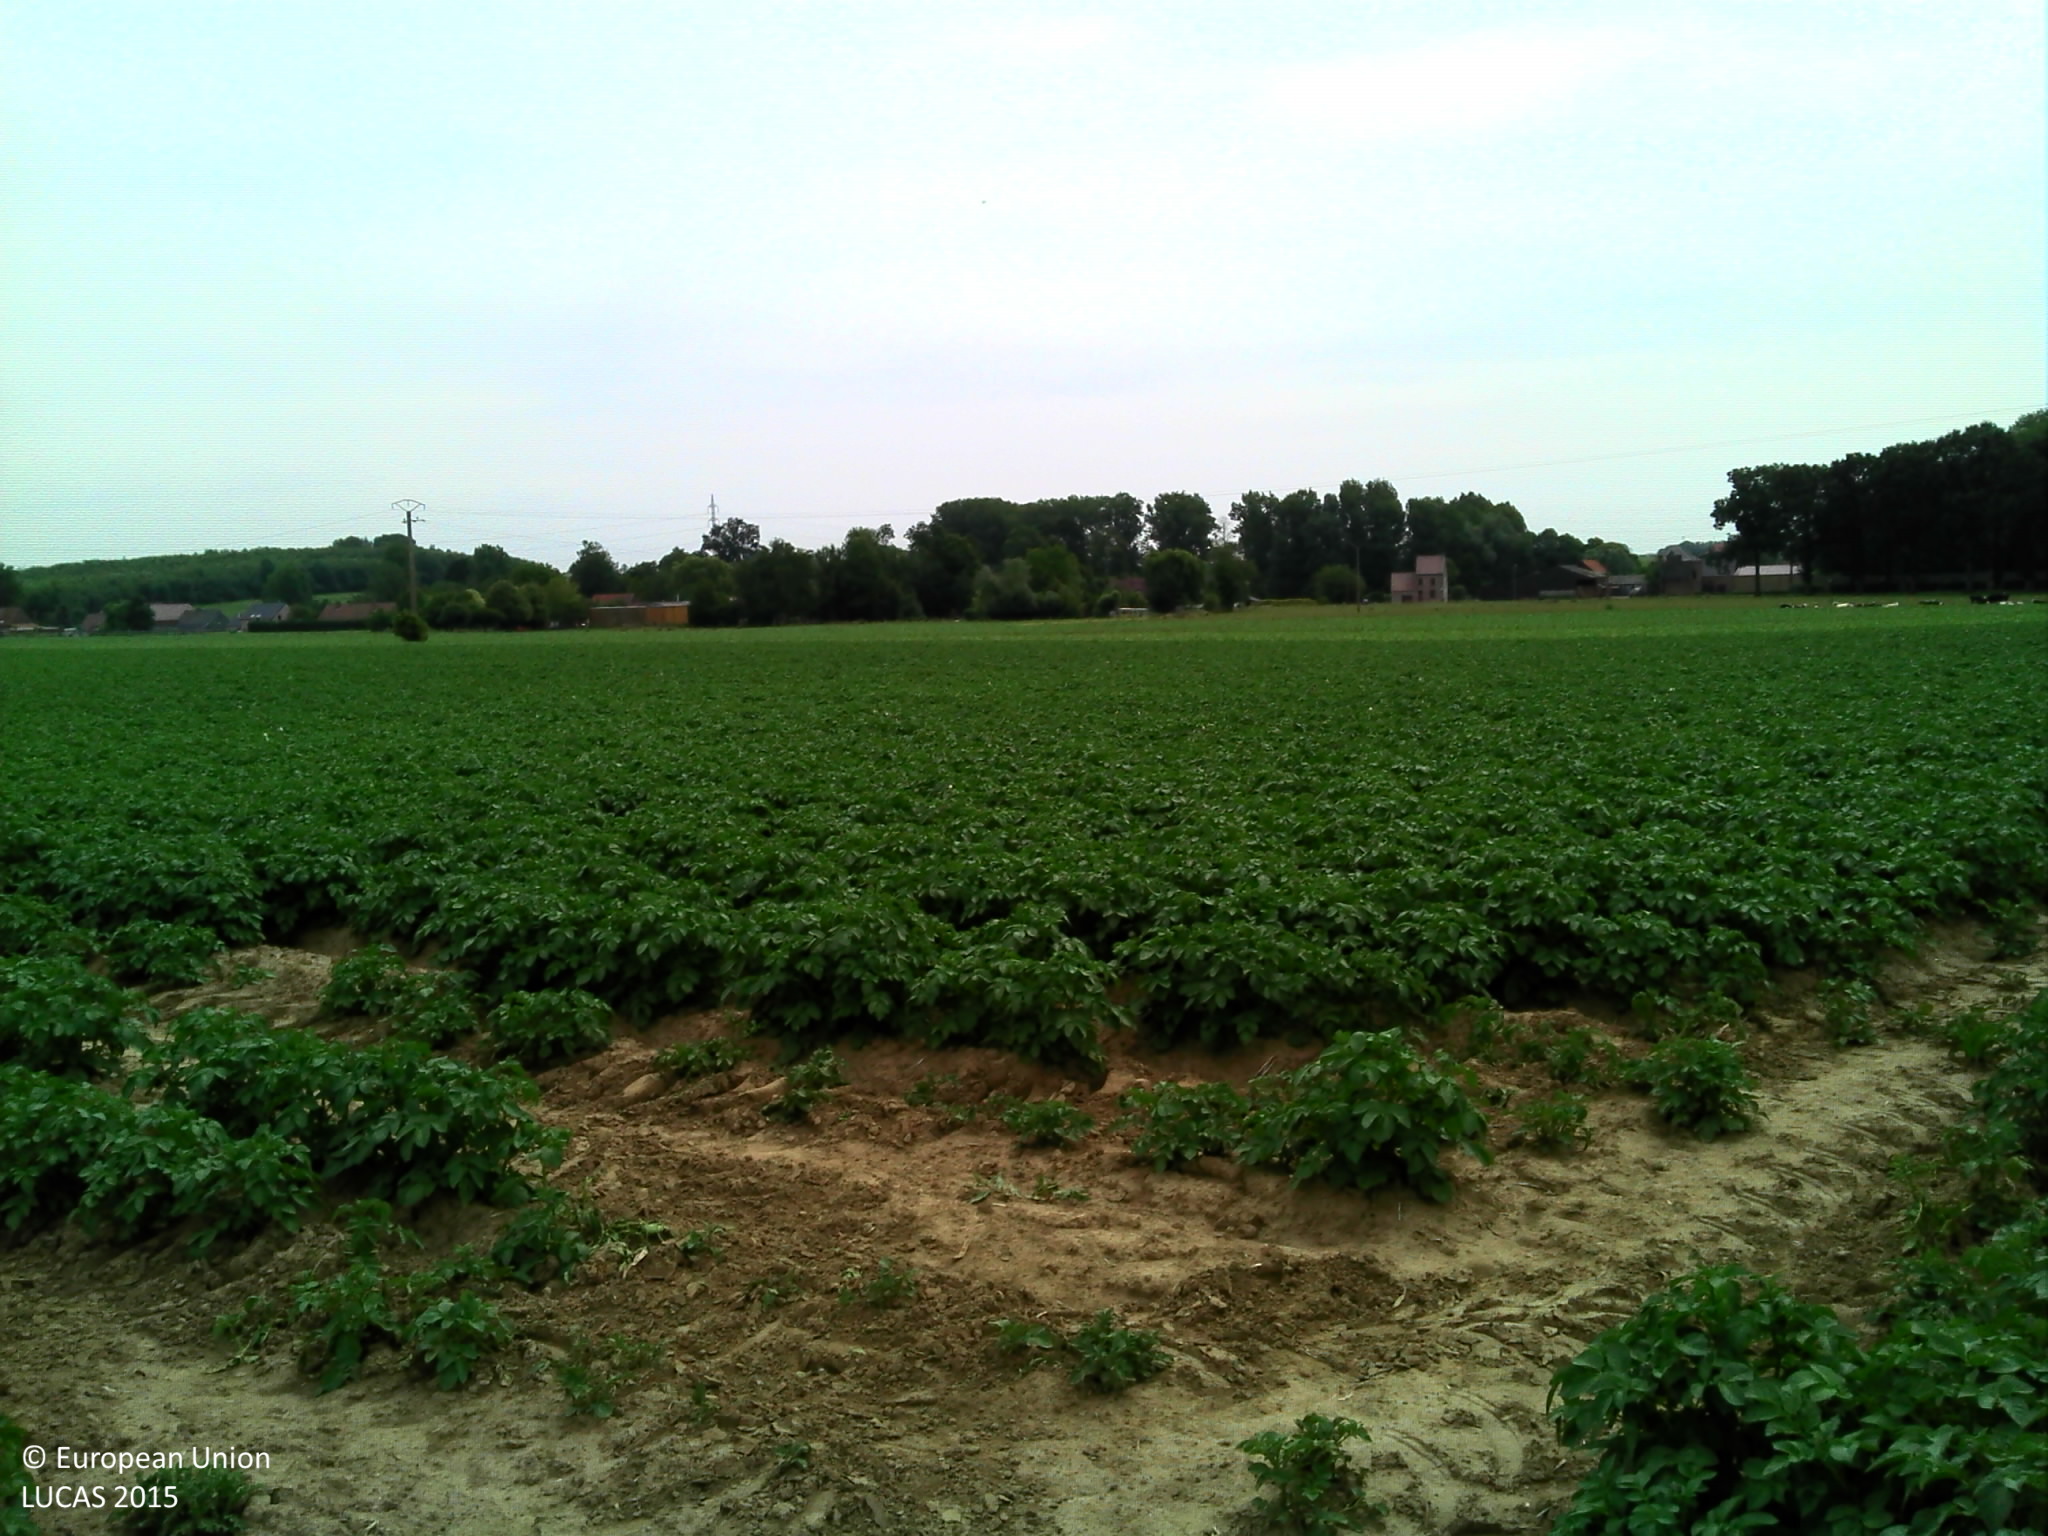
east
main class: Cropland
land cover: Potatoes
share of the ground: > 75 %
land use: Agriculture (excluding fallow land and kitchen gardens)
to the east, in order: Potatoes; Maize; Electric lines; Maize; Grass margins; Fences; Grassland without tree/shrub cover; Fences; Grassland without tree/shrub cover
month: June
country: BE
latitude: 50.6040
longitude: 3.6771
